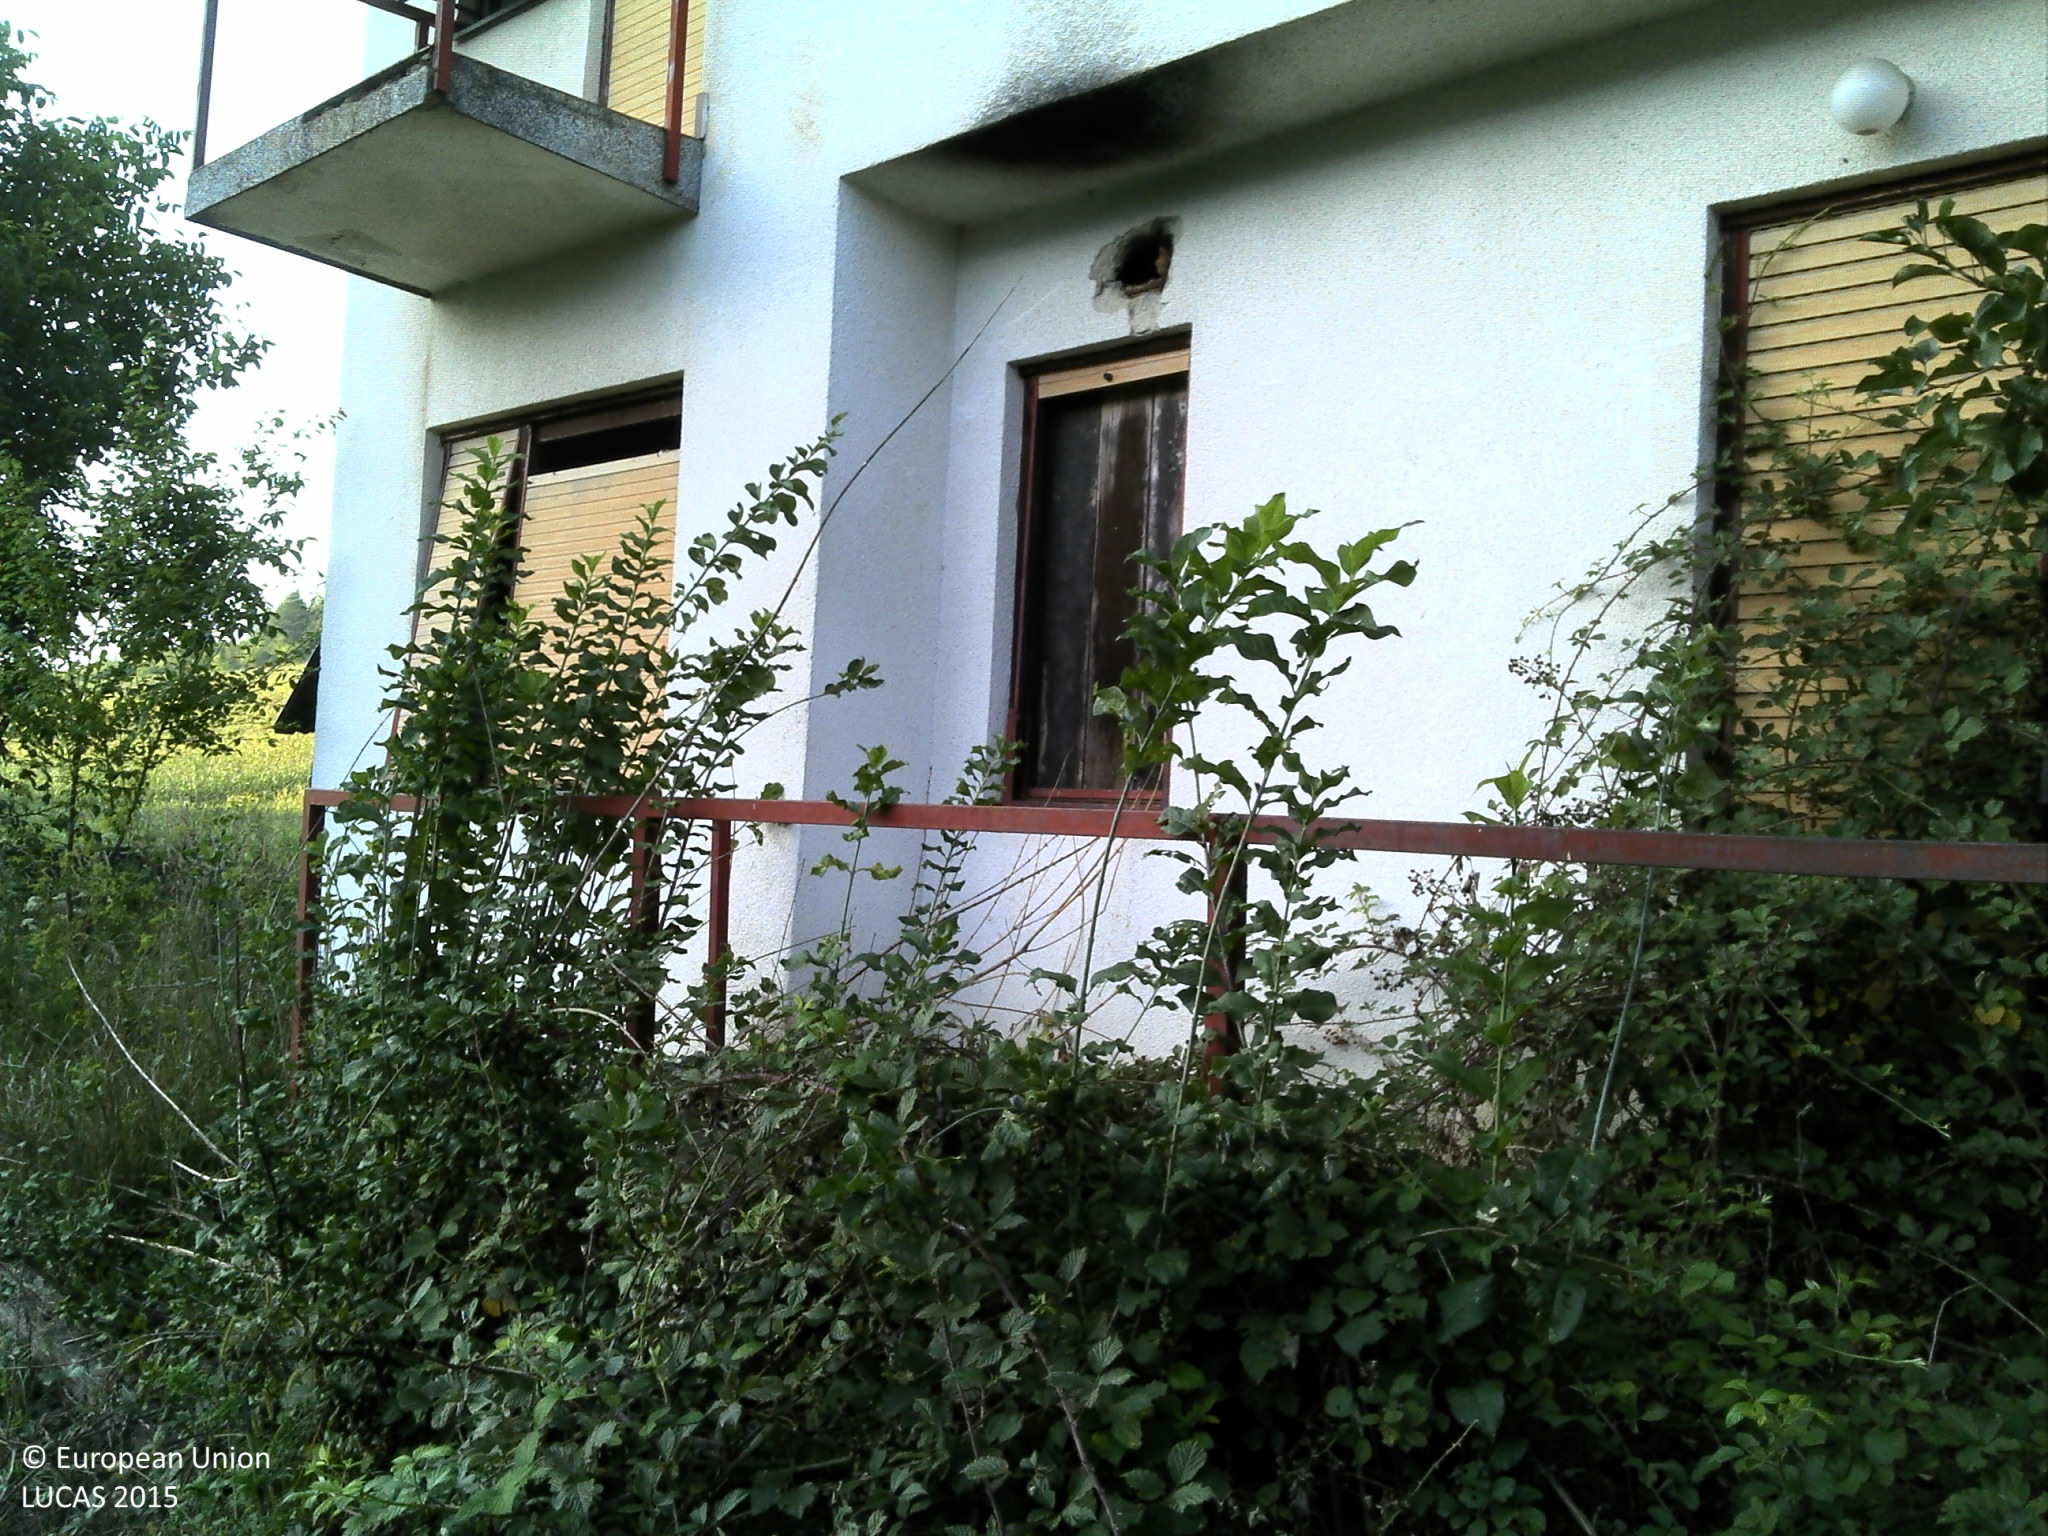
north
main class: Grassland
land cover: Grassland with sparse tree/shrub cover
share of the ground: > 75 %
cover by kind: herbaceous plants 90 %, broadleaved forest trees 5 %, shrubs 5 %
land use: Residential
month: August
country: HR
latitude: 45.2605
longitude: 15.6923
